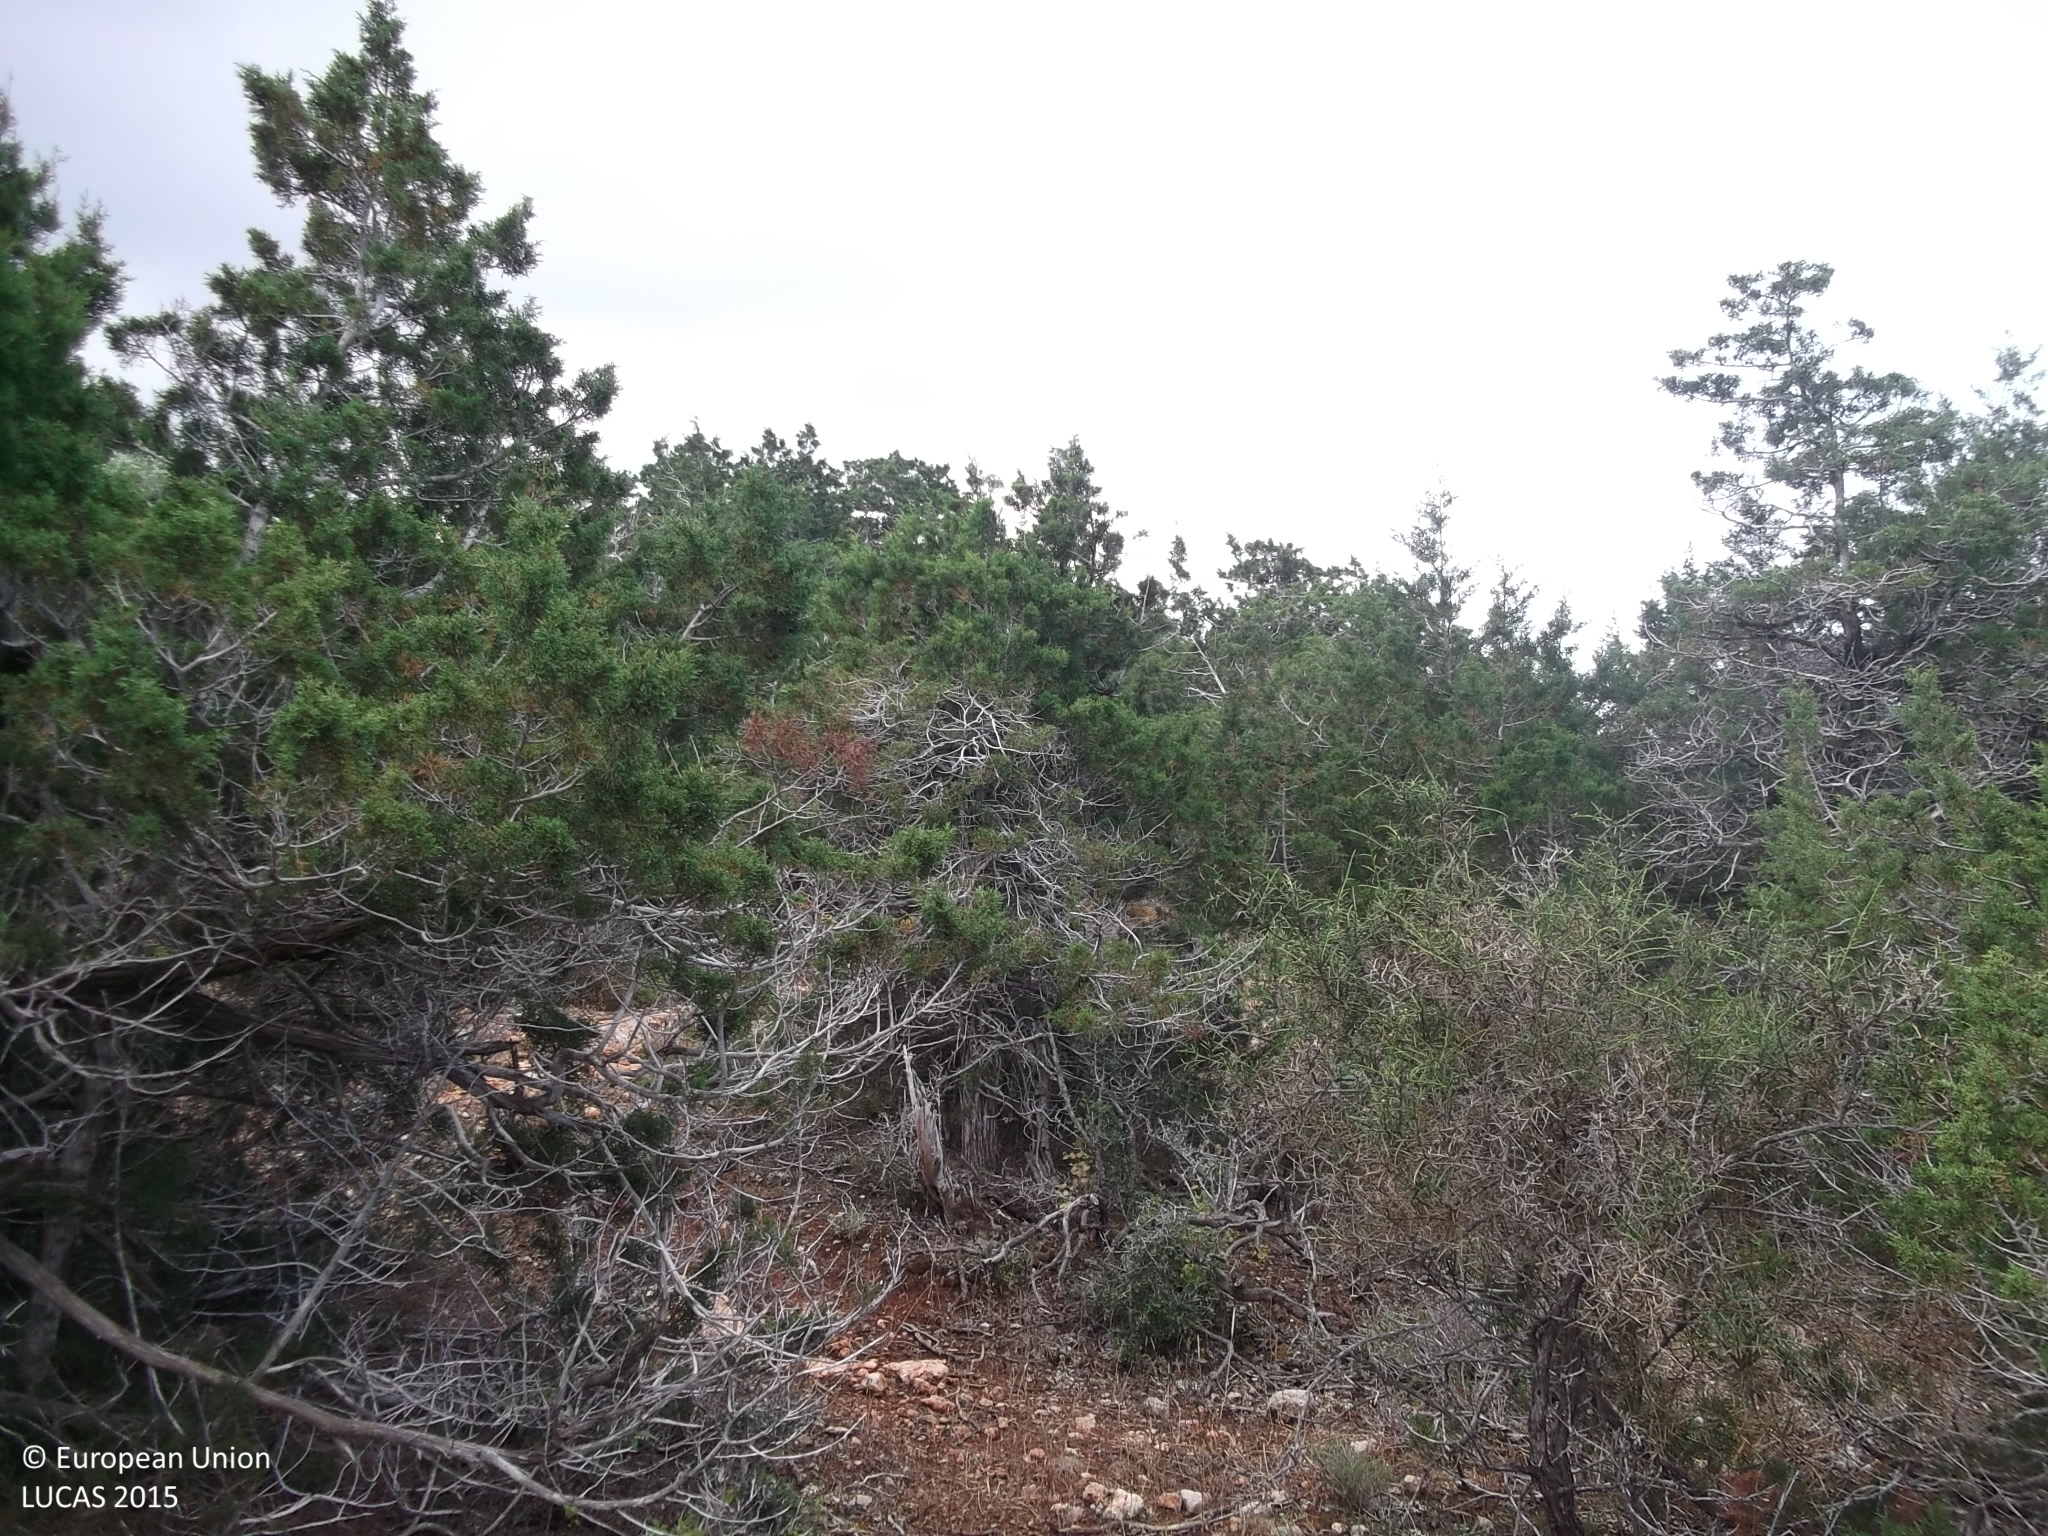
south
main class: Woodland
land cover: Other coniferous woodland
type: coniferous forest of the mediterranean region
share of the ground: > 75 %
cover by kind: coniferous forest trees 75 %, unconsolidated bare surface 15 %, shrubs 10 %
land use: Forestry
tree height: > 5 m
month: May
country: CY
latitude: 35.0611
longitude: 32.3100
